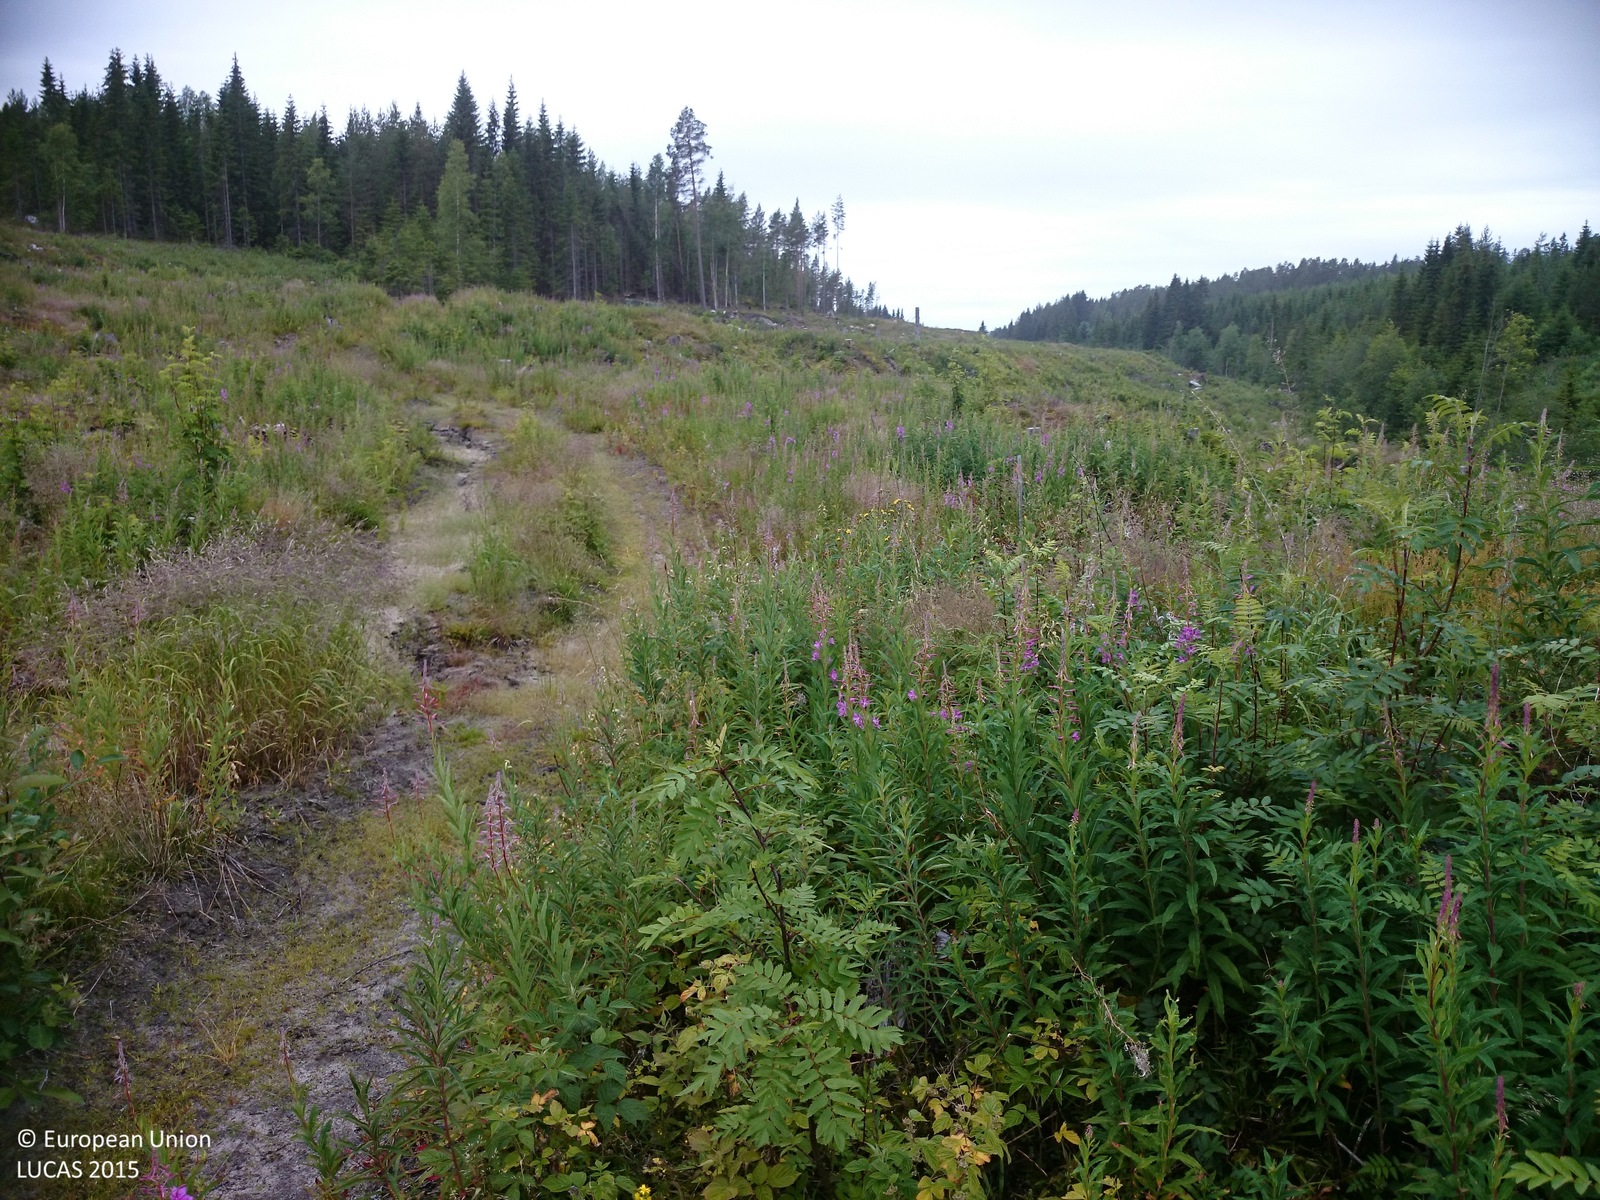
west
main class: Woodland
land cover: Pine dominated mixed woodland
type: boreal forest
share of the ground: 10 - 25 %
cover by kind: shrubs 40 %, herbaceous plants 40 %, coniferous forest trees 10 %, broadleaved forest trees 10 %
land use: Forestry
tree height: < 5 m
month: July
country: SE
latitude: 62.5522
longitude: 17.8565
